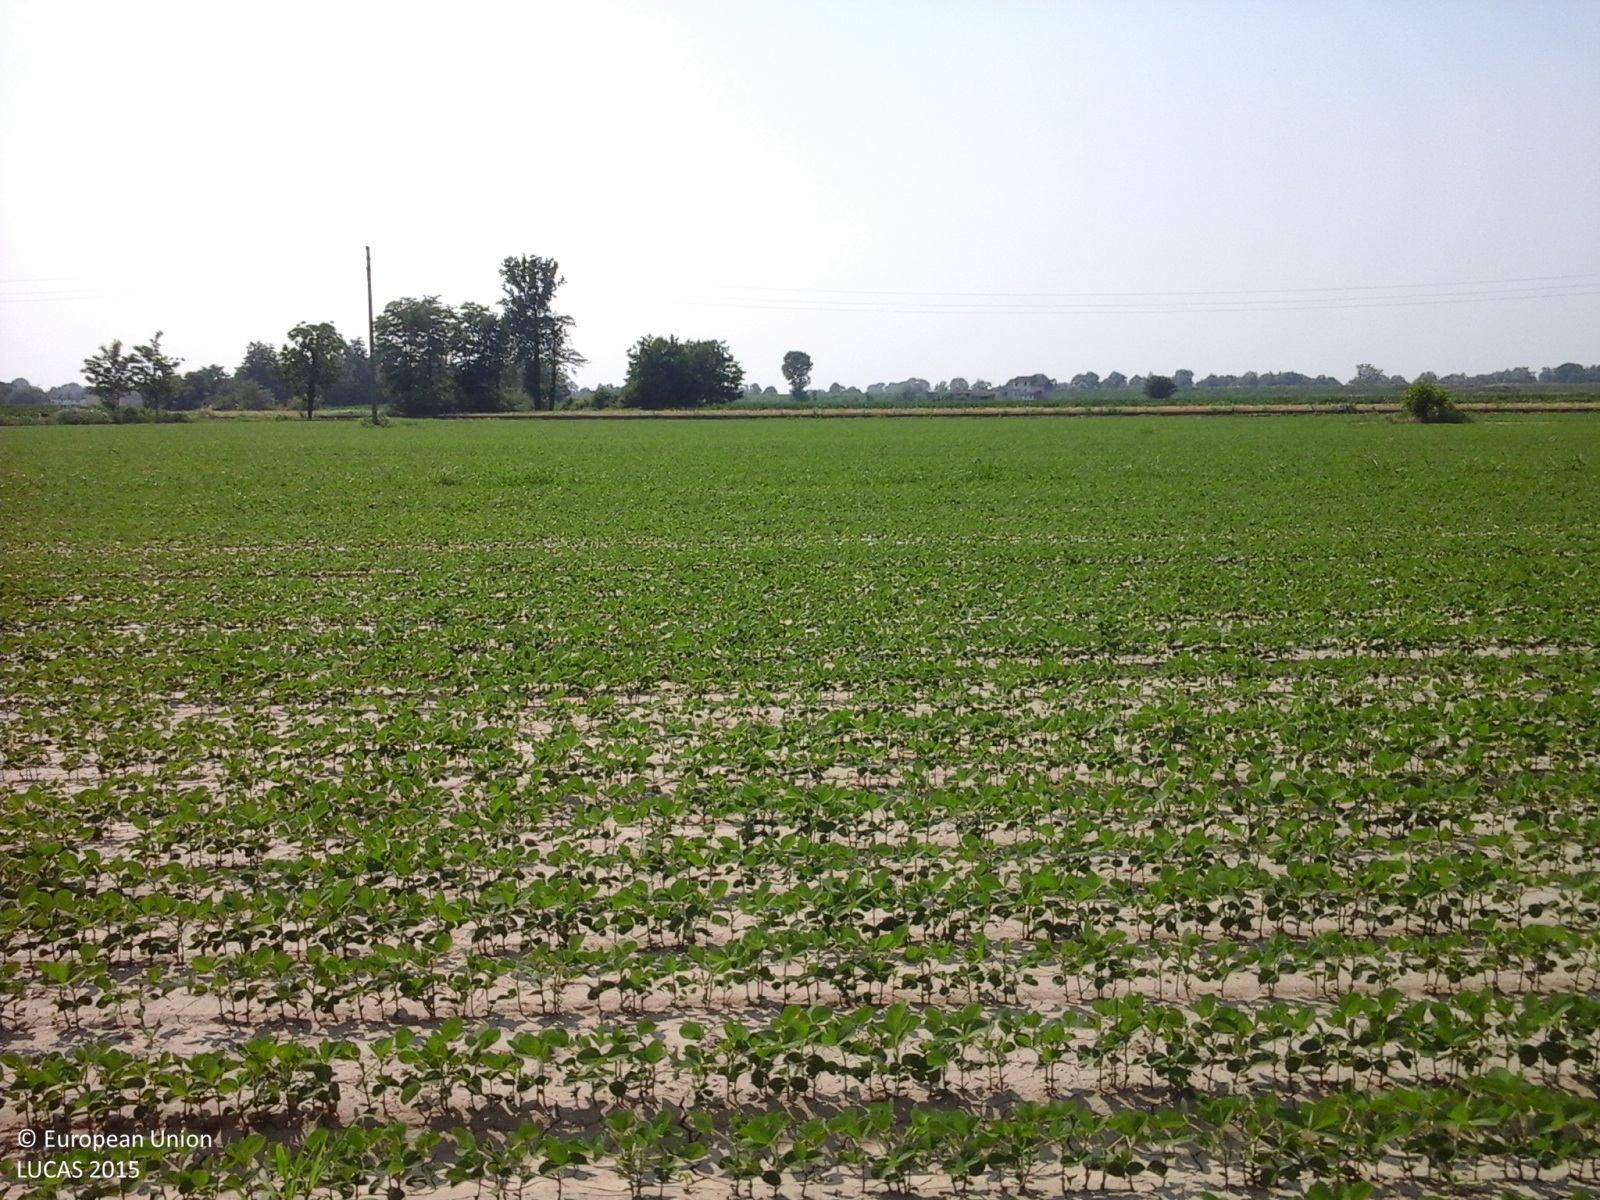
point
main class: Cropland
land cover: Soya
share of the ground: 25 - 50 %
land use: Agriculture (excluding fallow land and kitchen gardens)
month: June
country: IT
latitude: 45.1073
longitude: 9.6575
